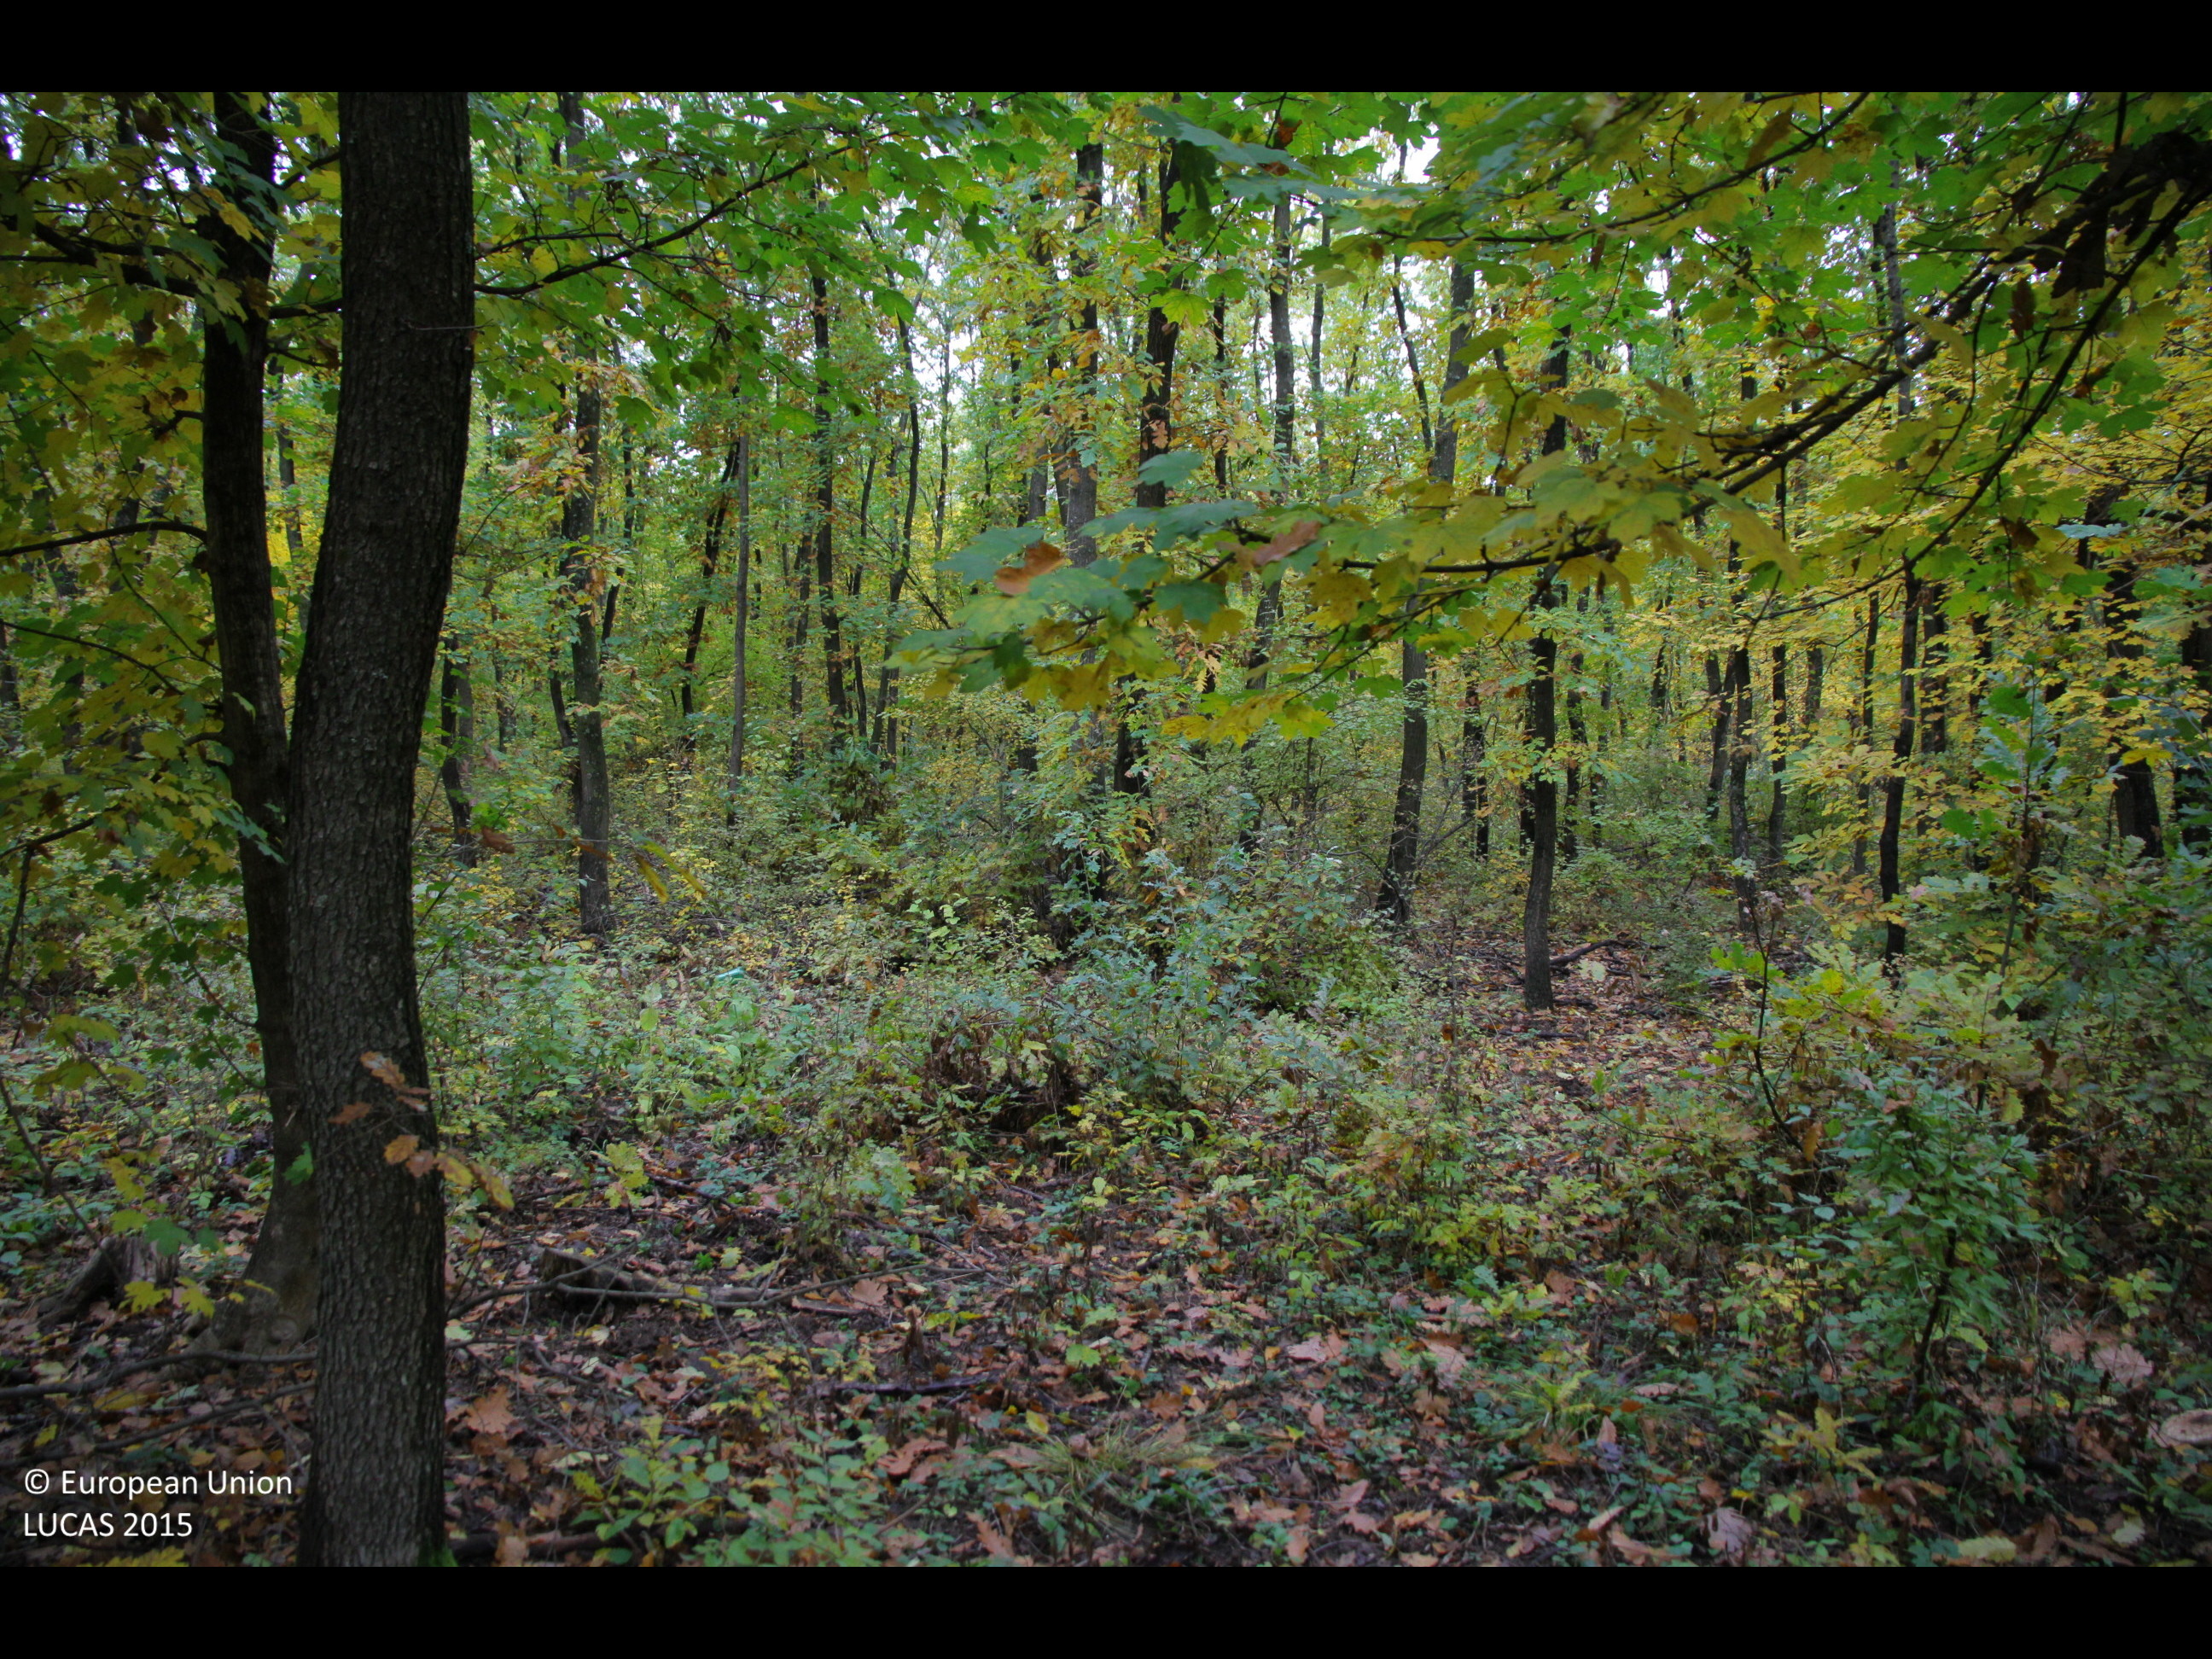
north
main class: Woodland
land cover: Broadleaved woodland
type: mesophytic deciduous forest
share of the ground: > 75 %
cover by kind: broadleaved forest trees 100 %
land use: Forestry
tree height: > 5 m
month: October
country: BG
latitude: 43.5299
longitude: 26.8554
